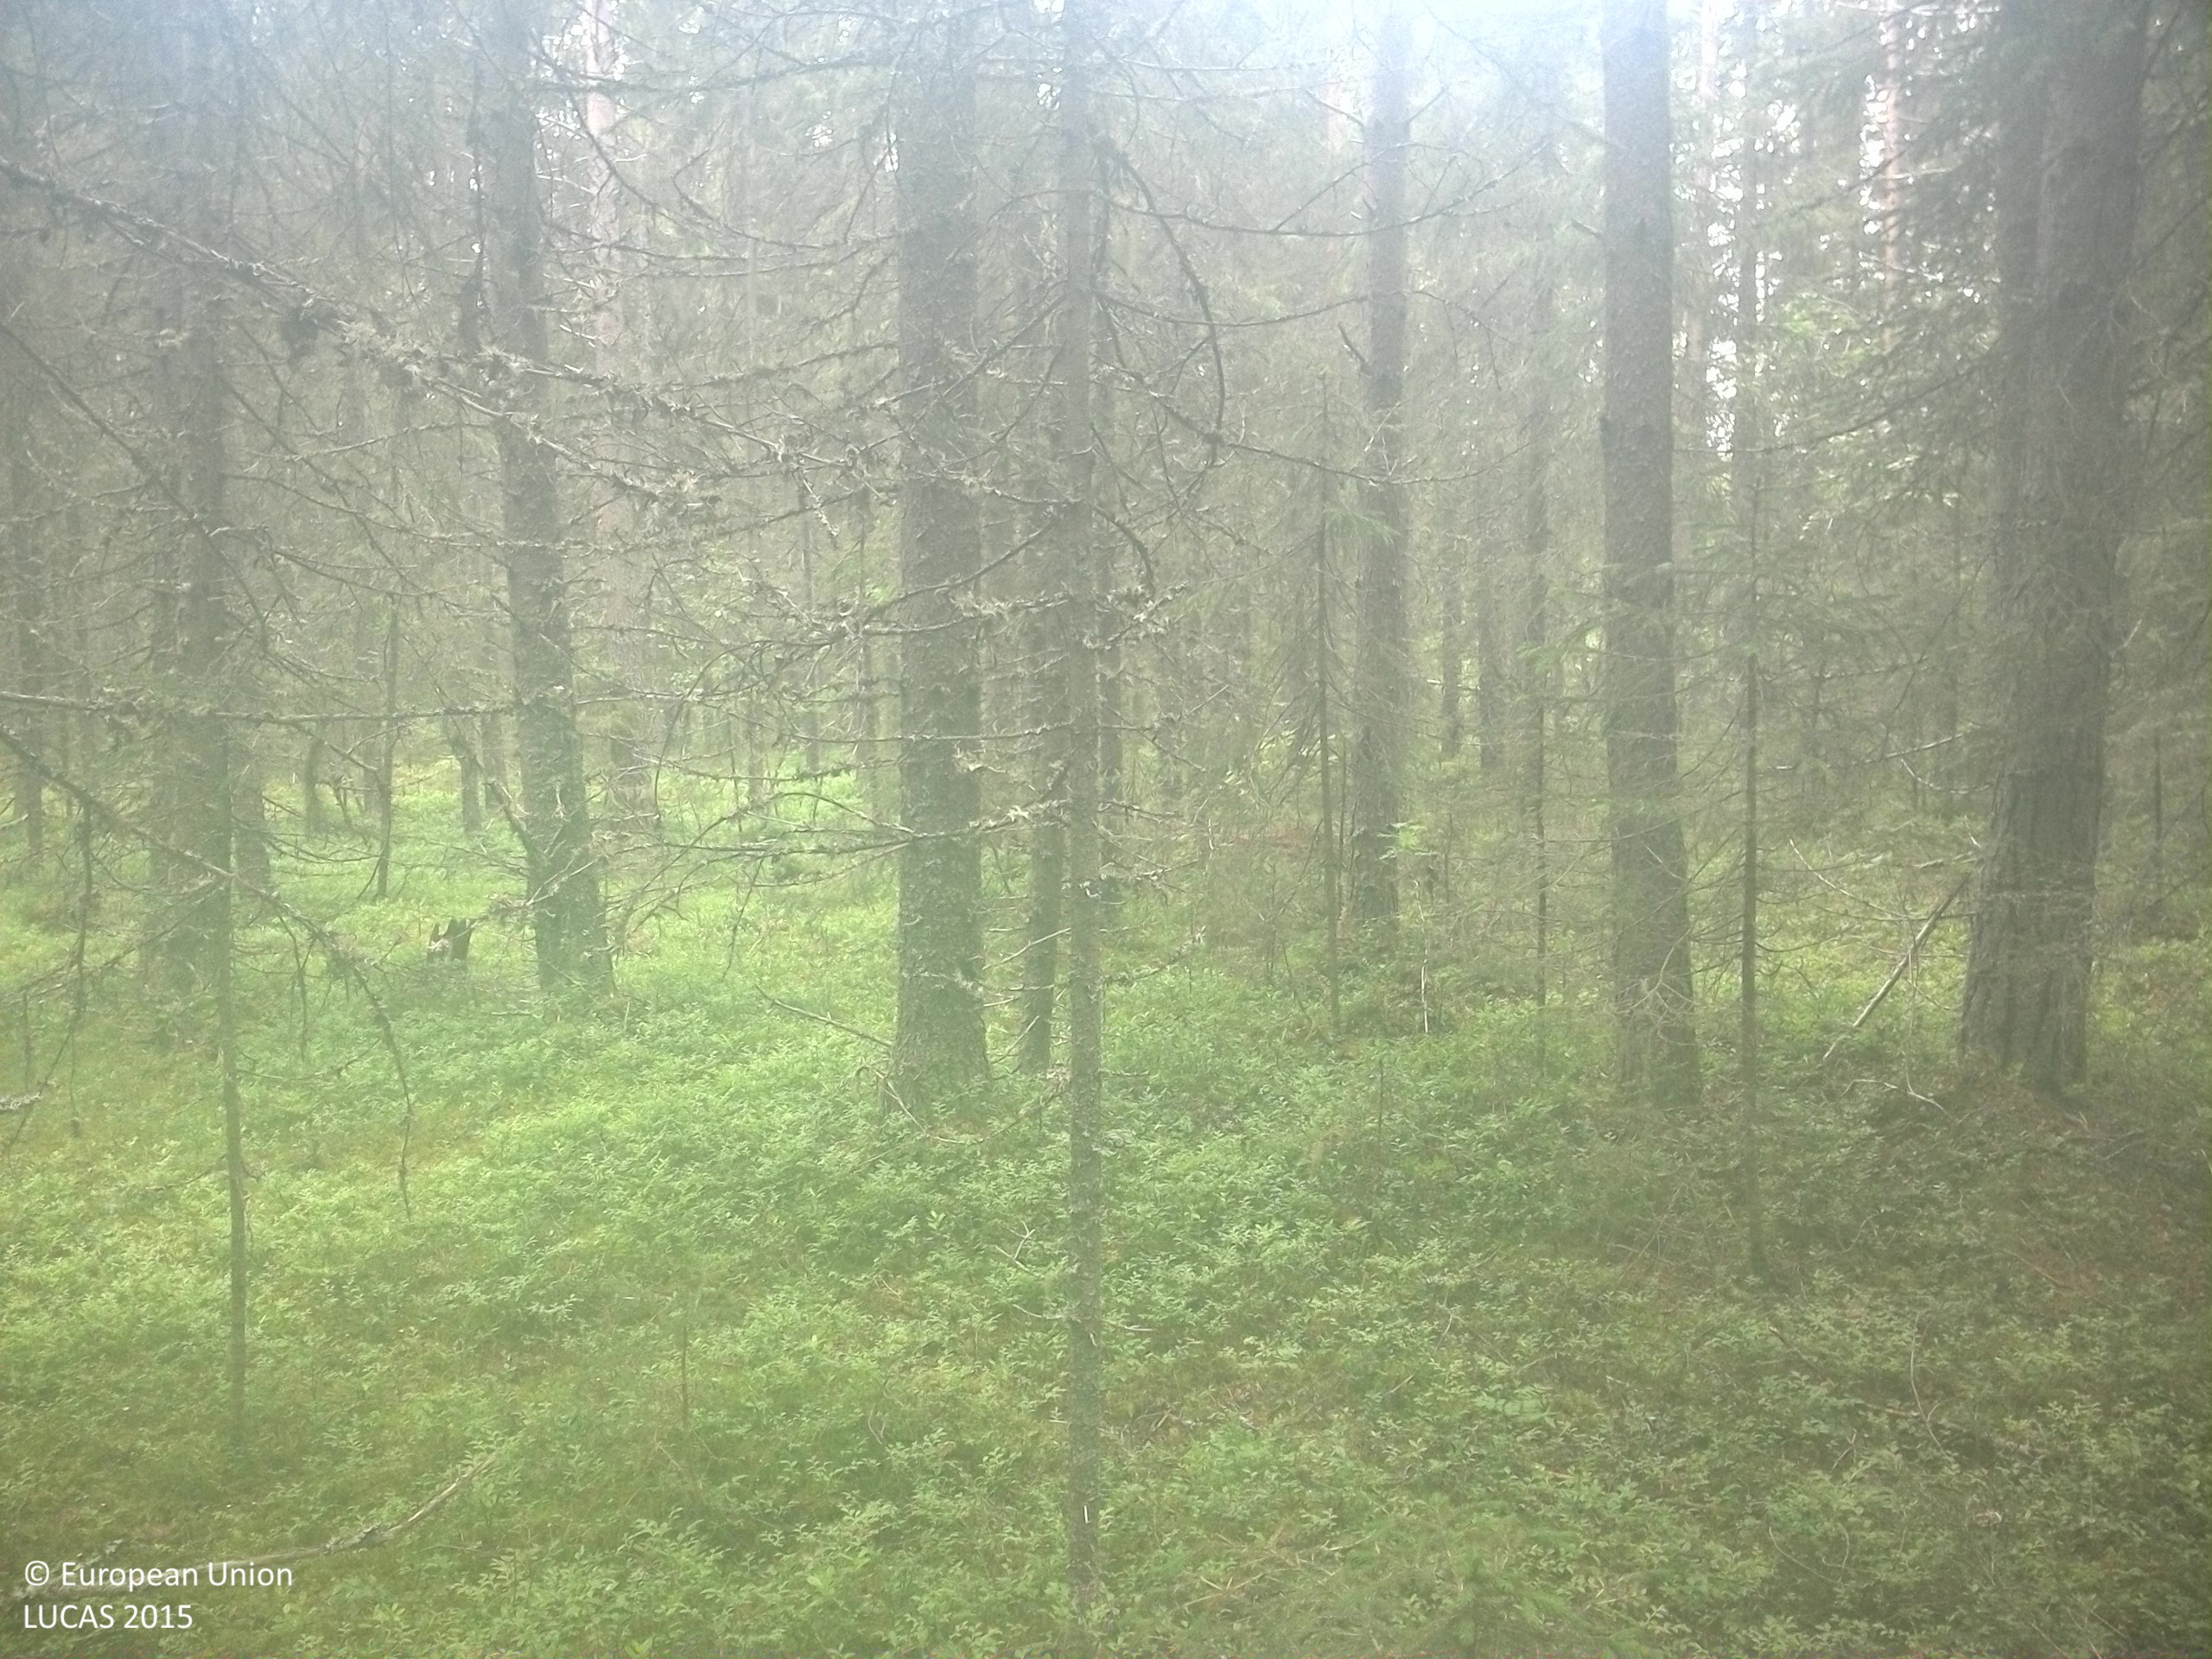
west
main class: Woodland
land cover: Spruce dominated coniferous woodland
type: boreal forest
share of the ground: > 75 %
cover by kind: coniferous forest trees 80 %, shrubs 15 %, broadleaved forest trees 5 %
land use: Forestry
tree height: > 5 m
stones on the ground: < 10 %
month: July
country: SE
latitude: 63.6222
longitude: 18.5492
